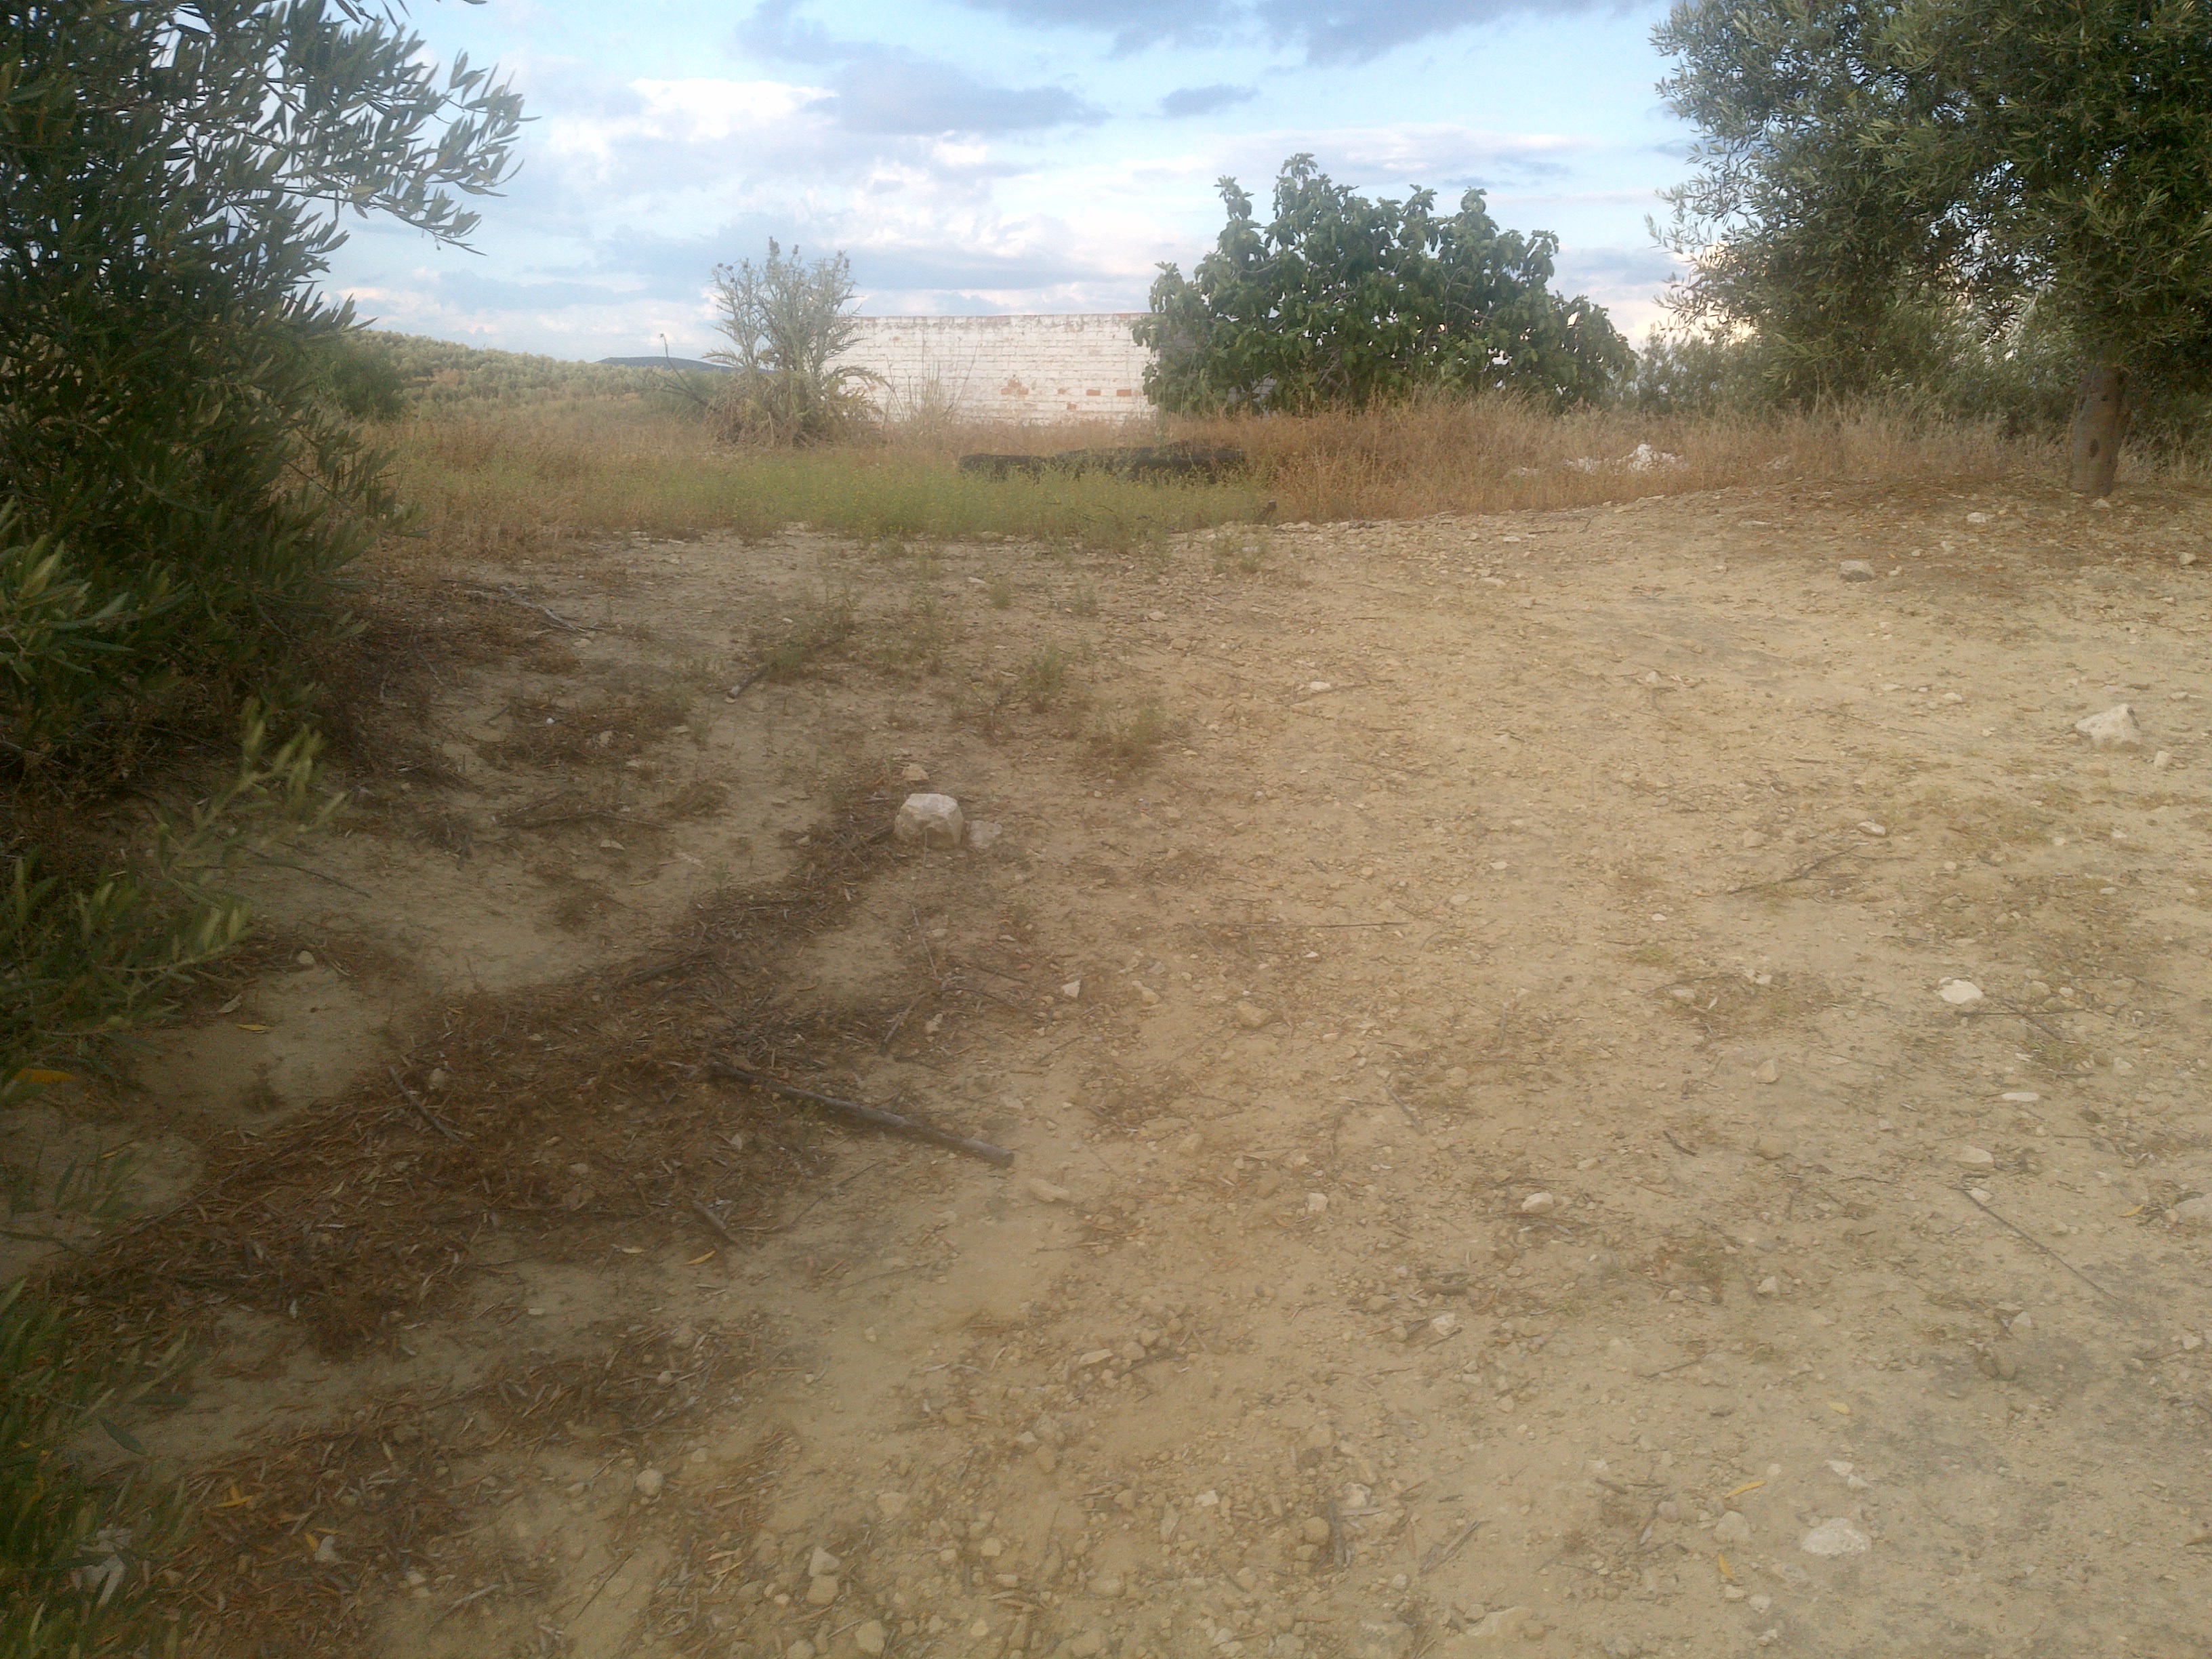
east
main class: Cropland
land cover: Olive groves
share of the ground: 25 - 50 %
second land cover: Other bare soil
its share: > 75 %
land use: Agriculture (excluding fallow land and kitchen gardens)
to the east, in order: Olive groves; Other bare soil; Grassland without tree/shrub cover; Artificial constructions in urban areas; Olive groves; Grass margins; Artificial constructions in urban areas; Olive groves; Grass margins; Tracks; Grass margins; Olive groves
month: June
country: ES
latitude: 37.7011
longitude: -4.4684
